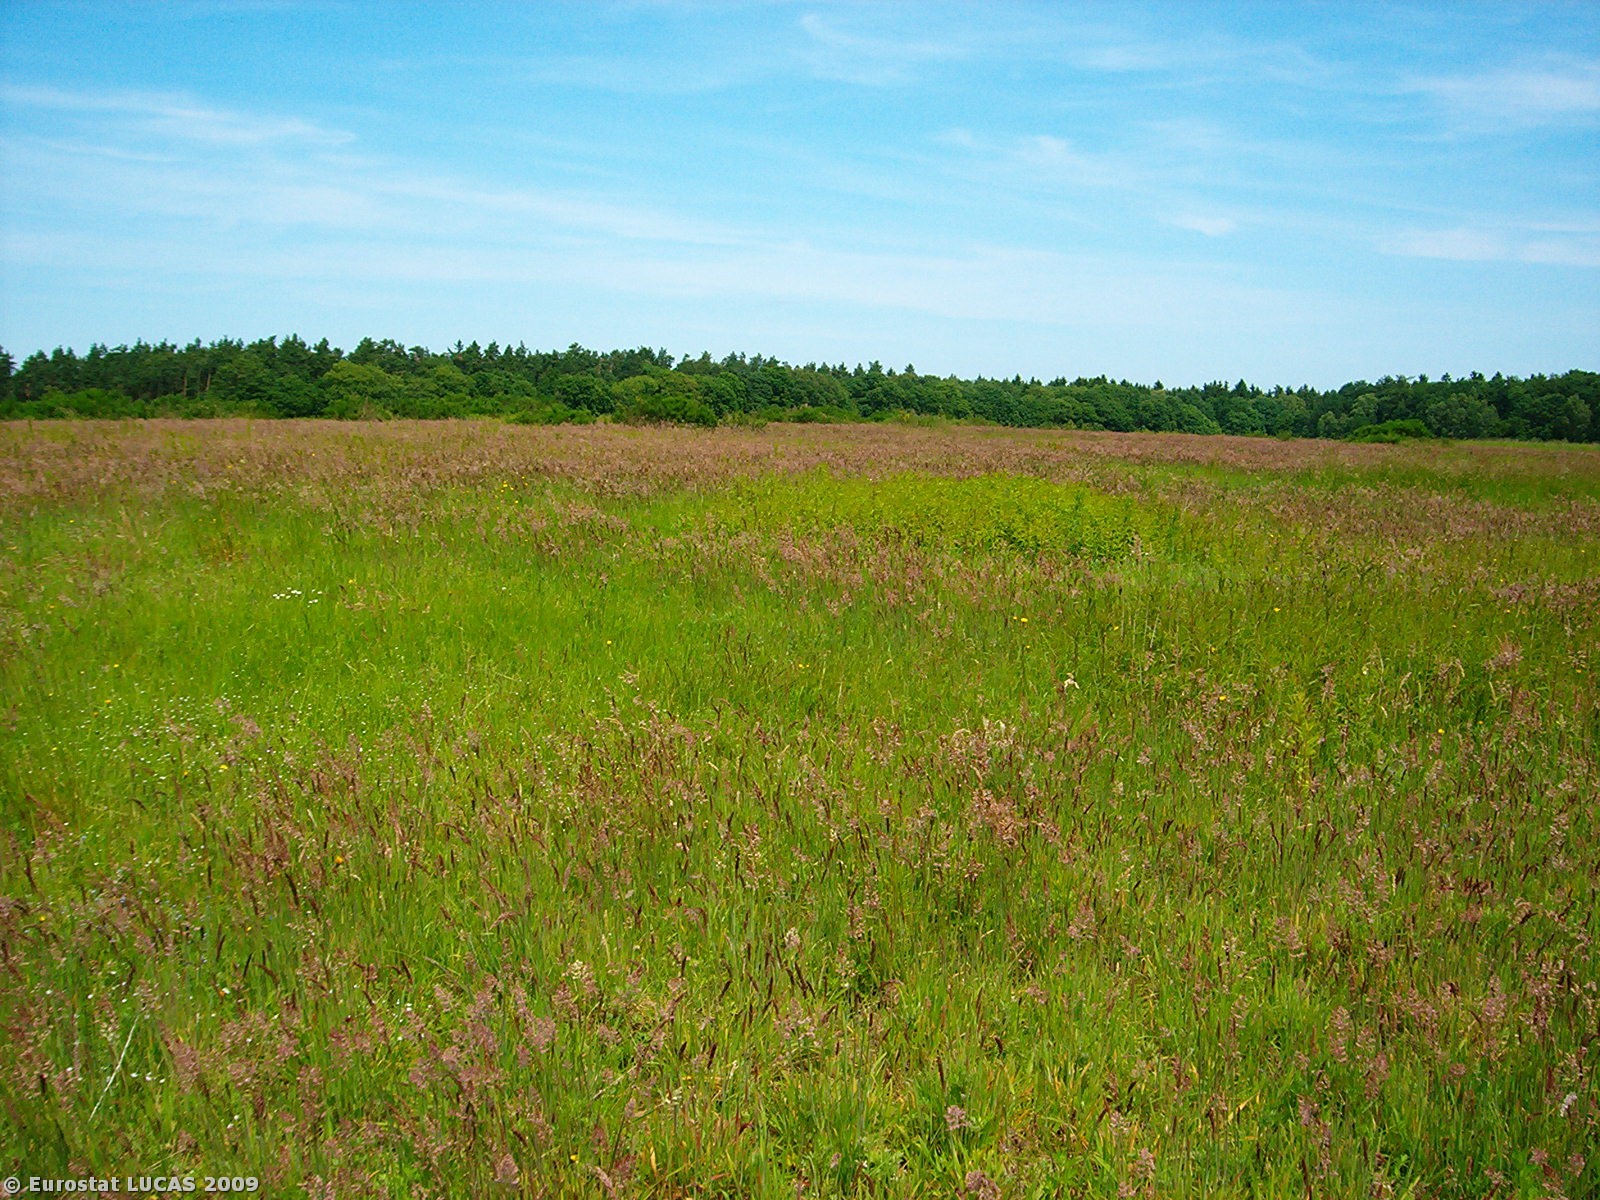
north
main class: Grassland
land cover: Grassland with sparse tree/shrub cover
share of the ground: > 75 %
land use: Unused
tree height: < 5 m
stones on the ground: < 10 %
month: June
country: PL
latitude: 53.8361
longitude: 15.4888
